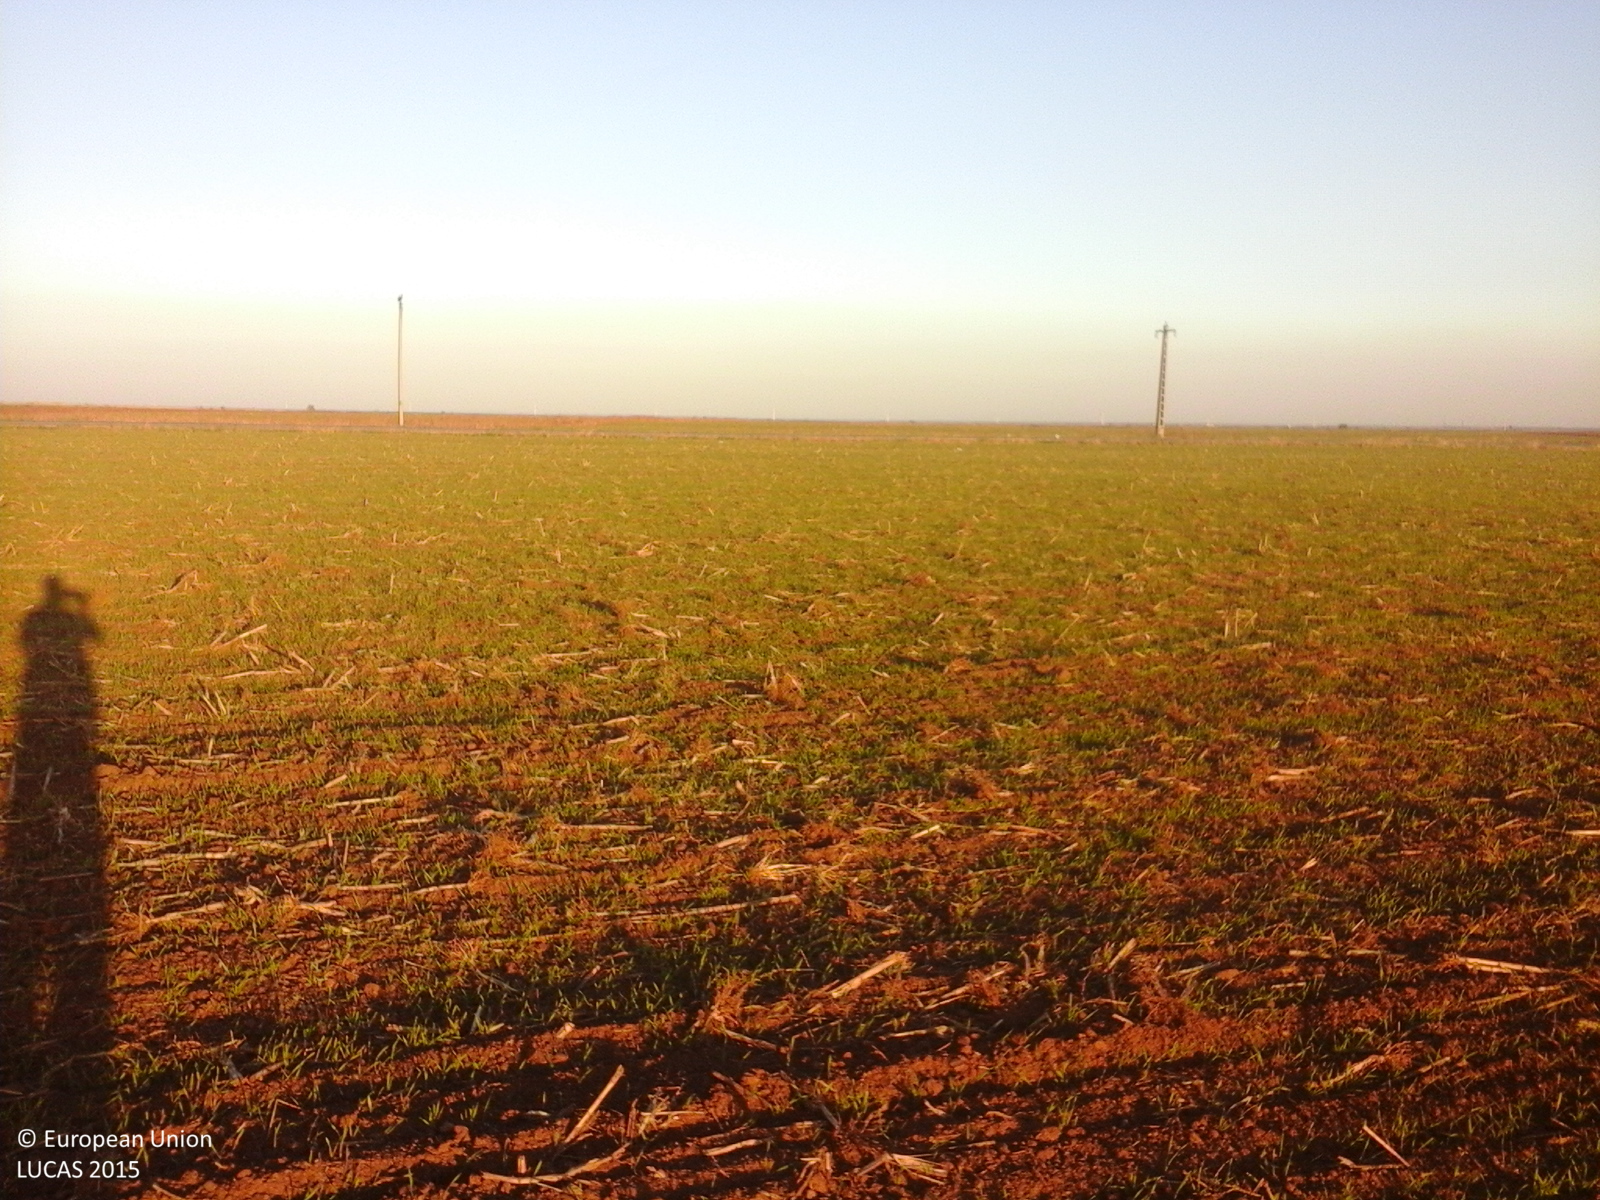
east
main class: Cropland
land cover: Common wheat
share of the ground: 10 - 25 %
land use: Agriculture (excluding fallow land and kitchen gardens)
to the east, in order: Common wheat; Grass margins; Ditches and canals; Paved roads, cycling and walking lanes; Ditches and canals; Grass margins; Common wheat; Electric lines; Common wheat
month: October
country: RO
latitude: 45.7869
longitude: 27.1114
